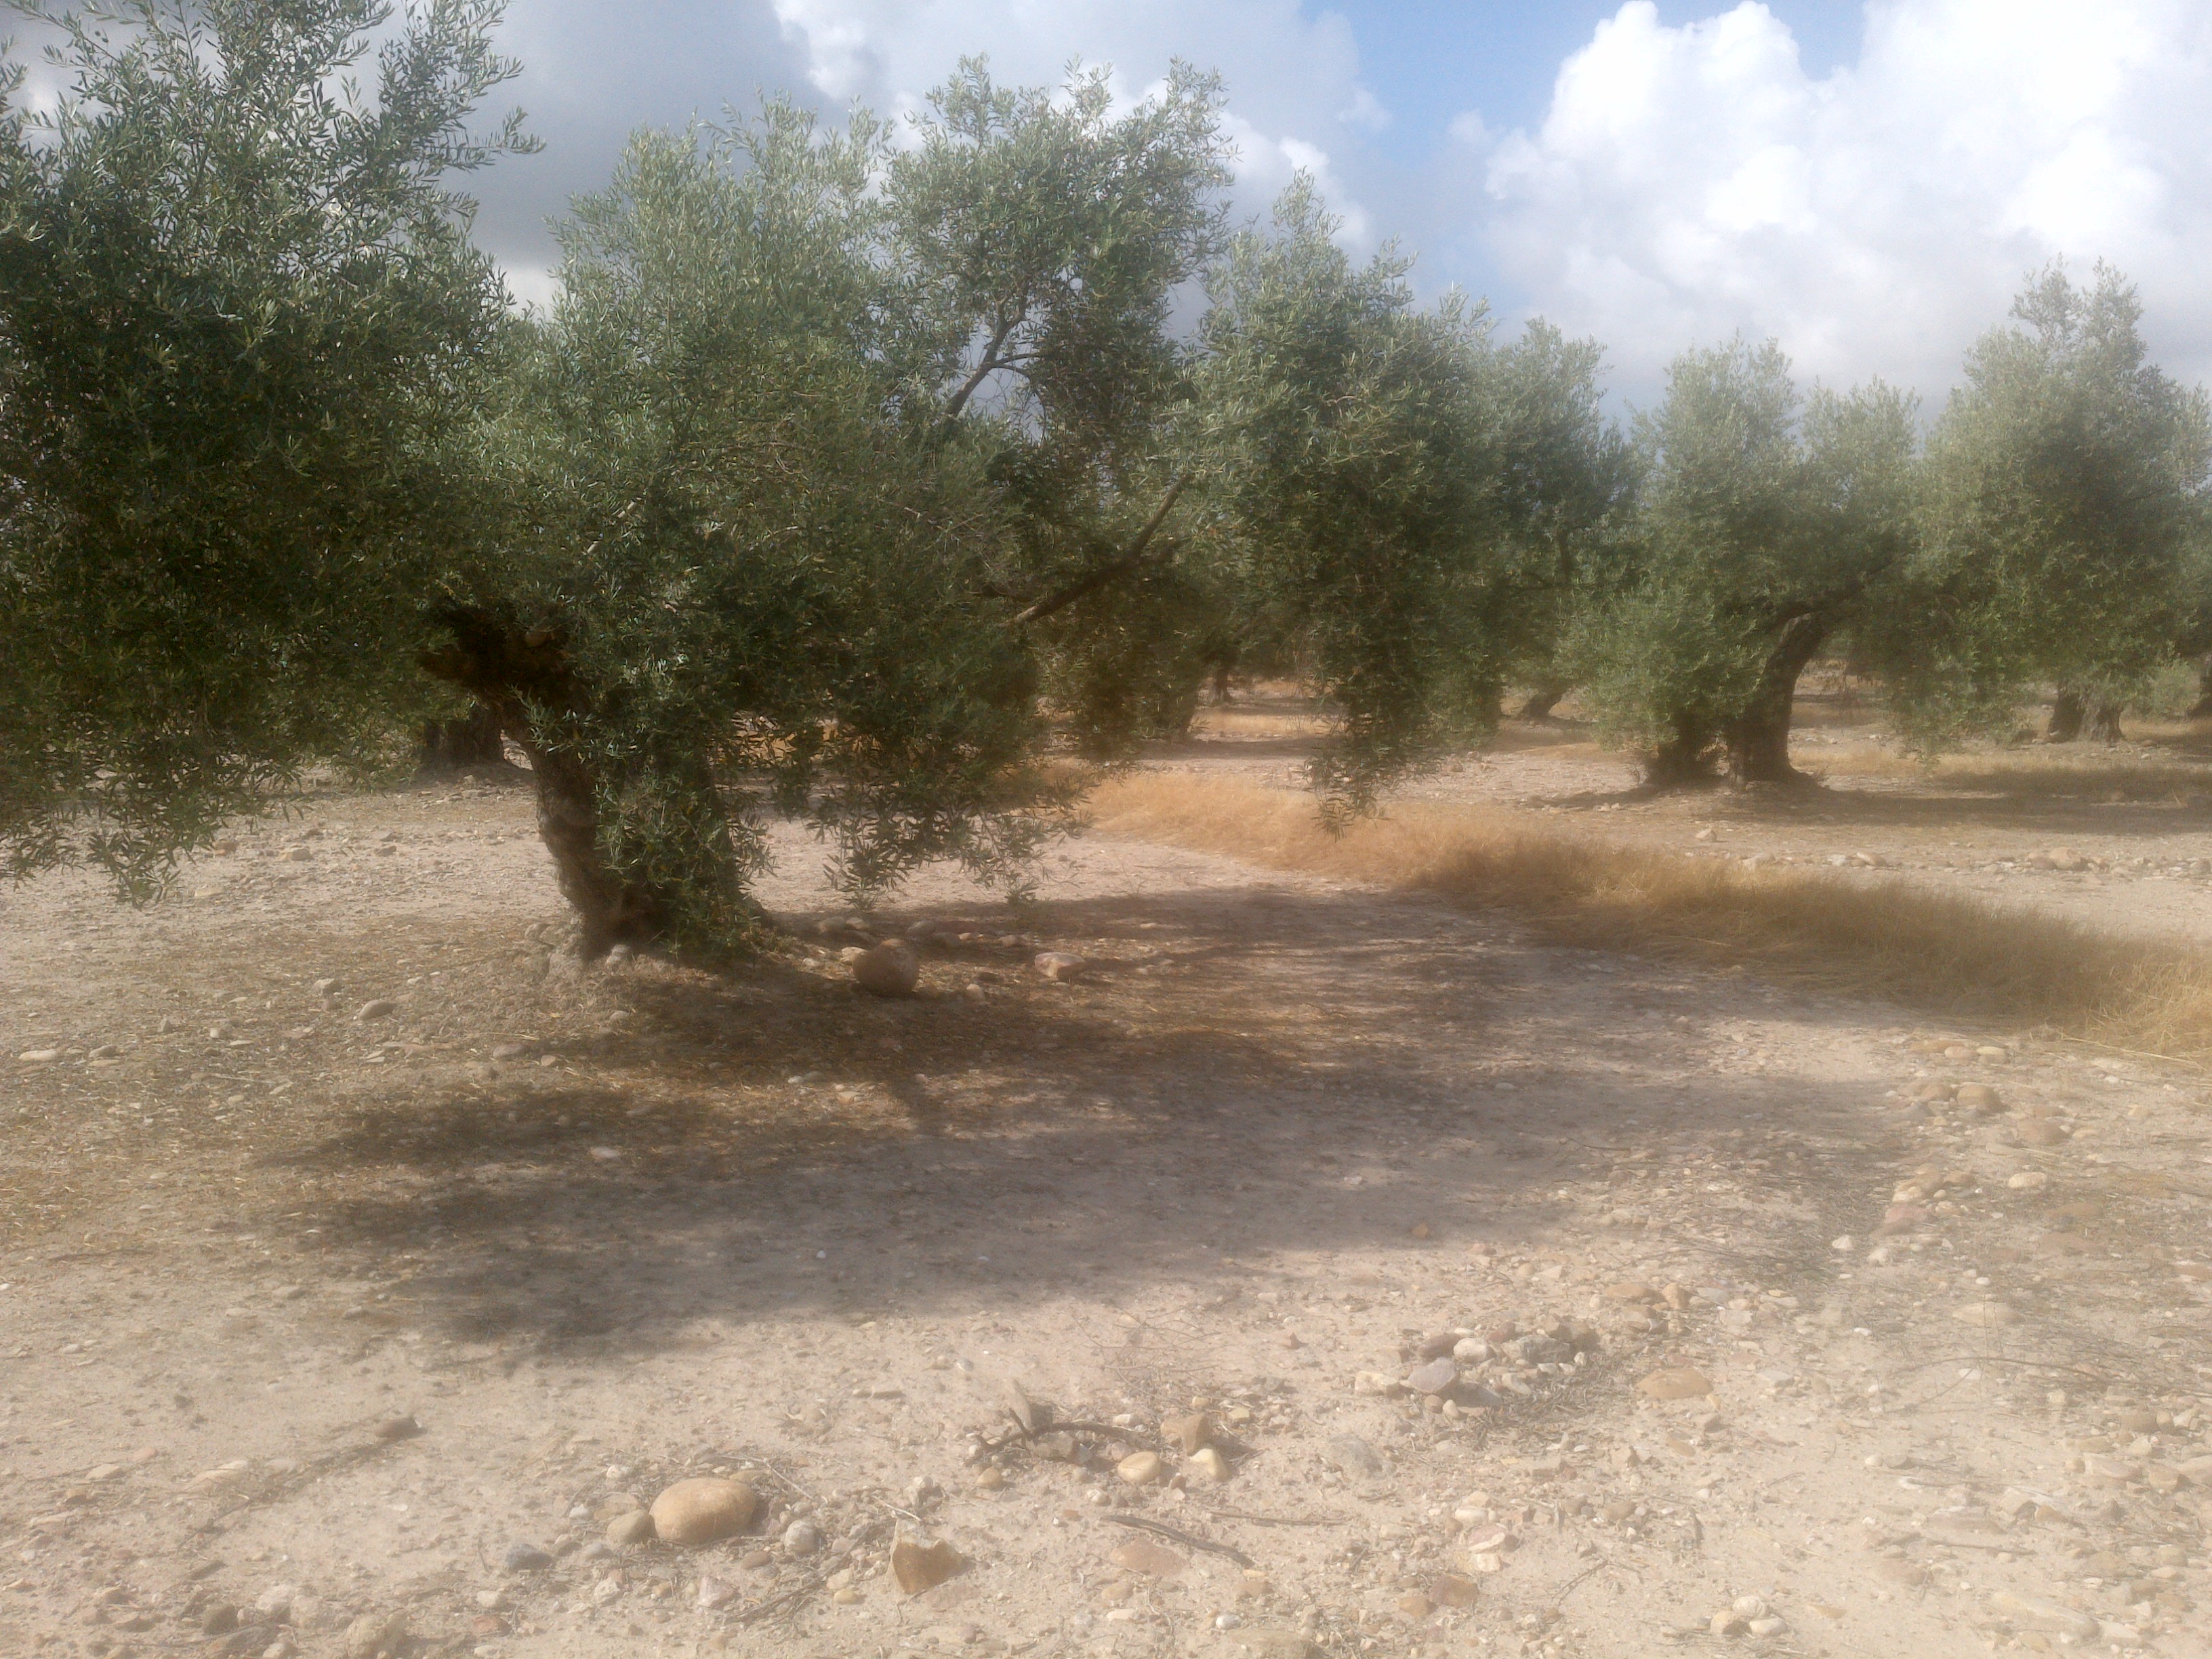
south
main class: Cropland
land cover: Olive groves
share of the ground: 25 - 50 %
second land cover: Spontaneously vegetated surfaces
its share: 10 - 25 %
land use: Agriculture (excluding fallow land and kitchen gardens)
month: June
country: ES
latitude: 37.9323
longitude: -4.5180
